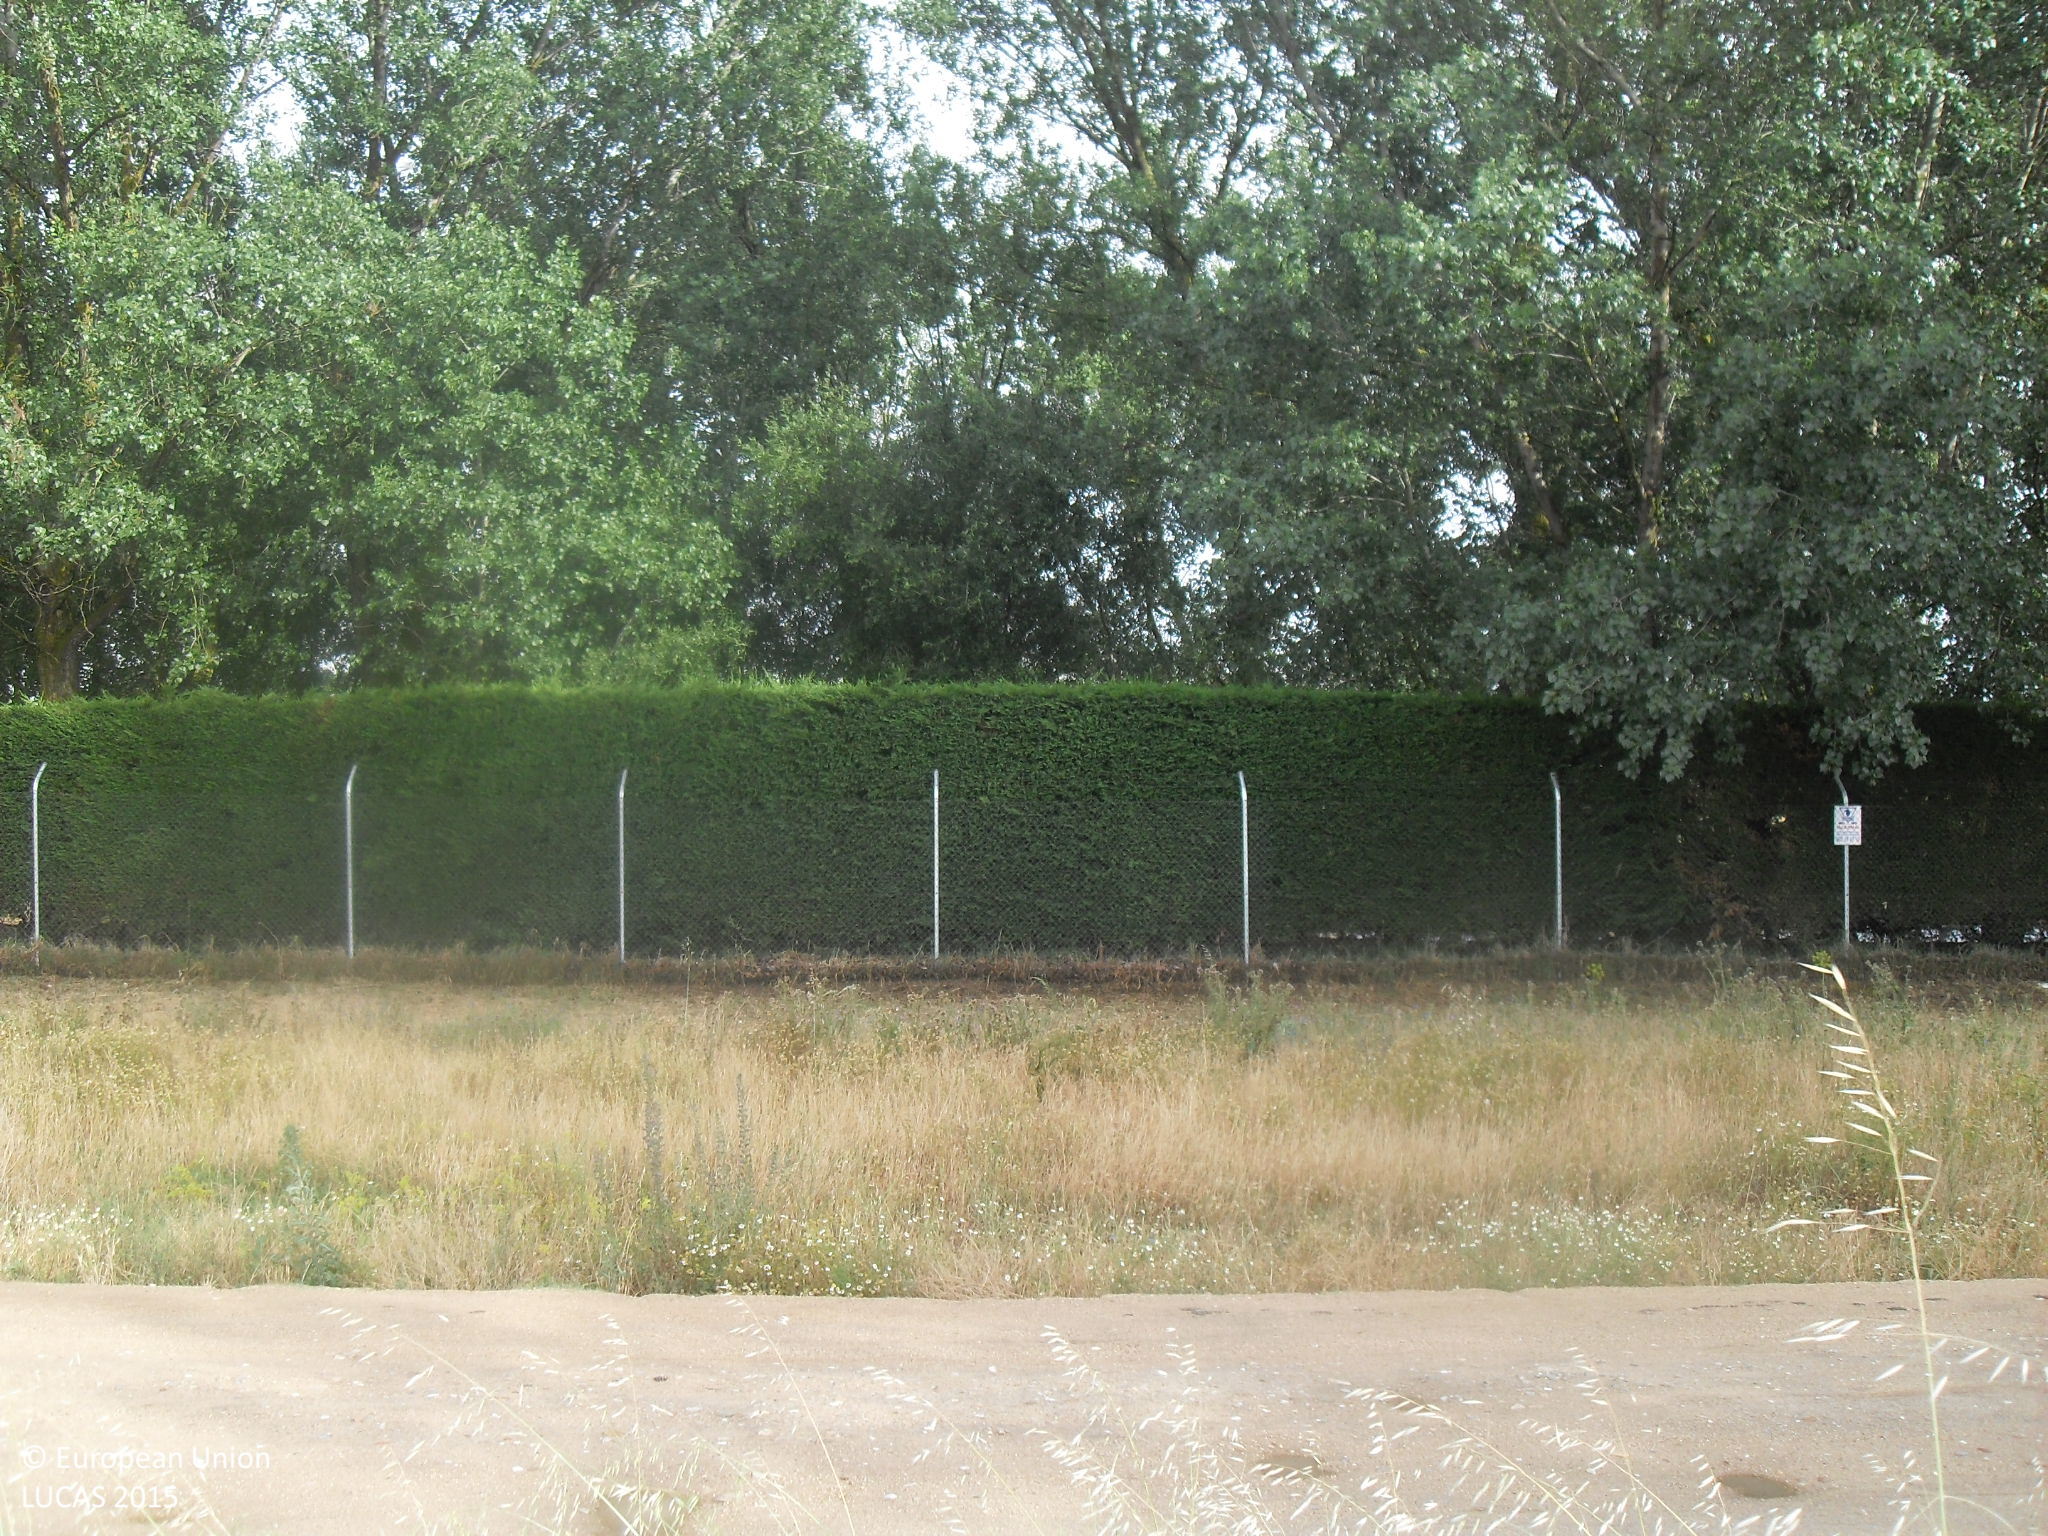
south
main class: Grassland
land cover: Spontaneously vegetated surfaces
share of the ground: > 75 %
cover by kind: herbaceous plants 100 %
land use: Abandoned areas
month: June
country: ES
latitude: 41.0179
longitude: -5.6924
